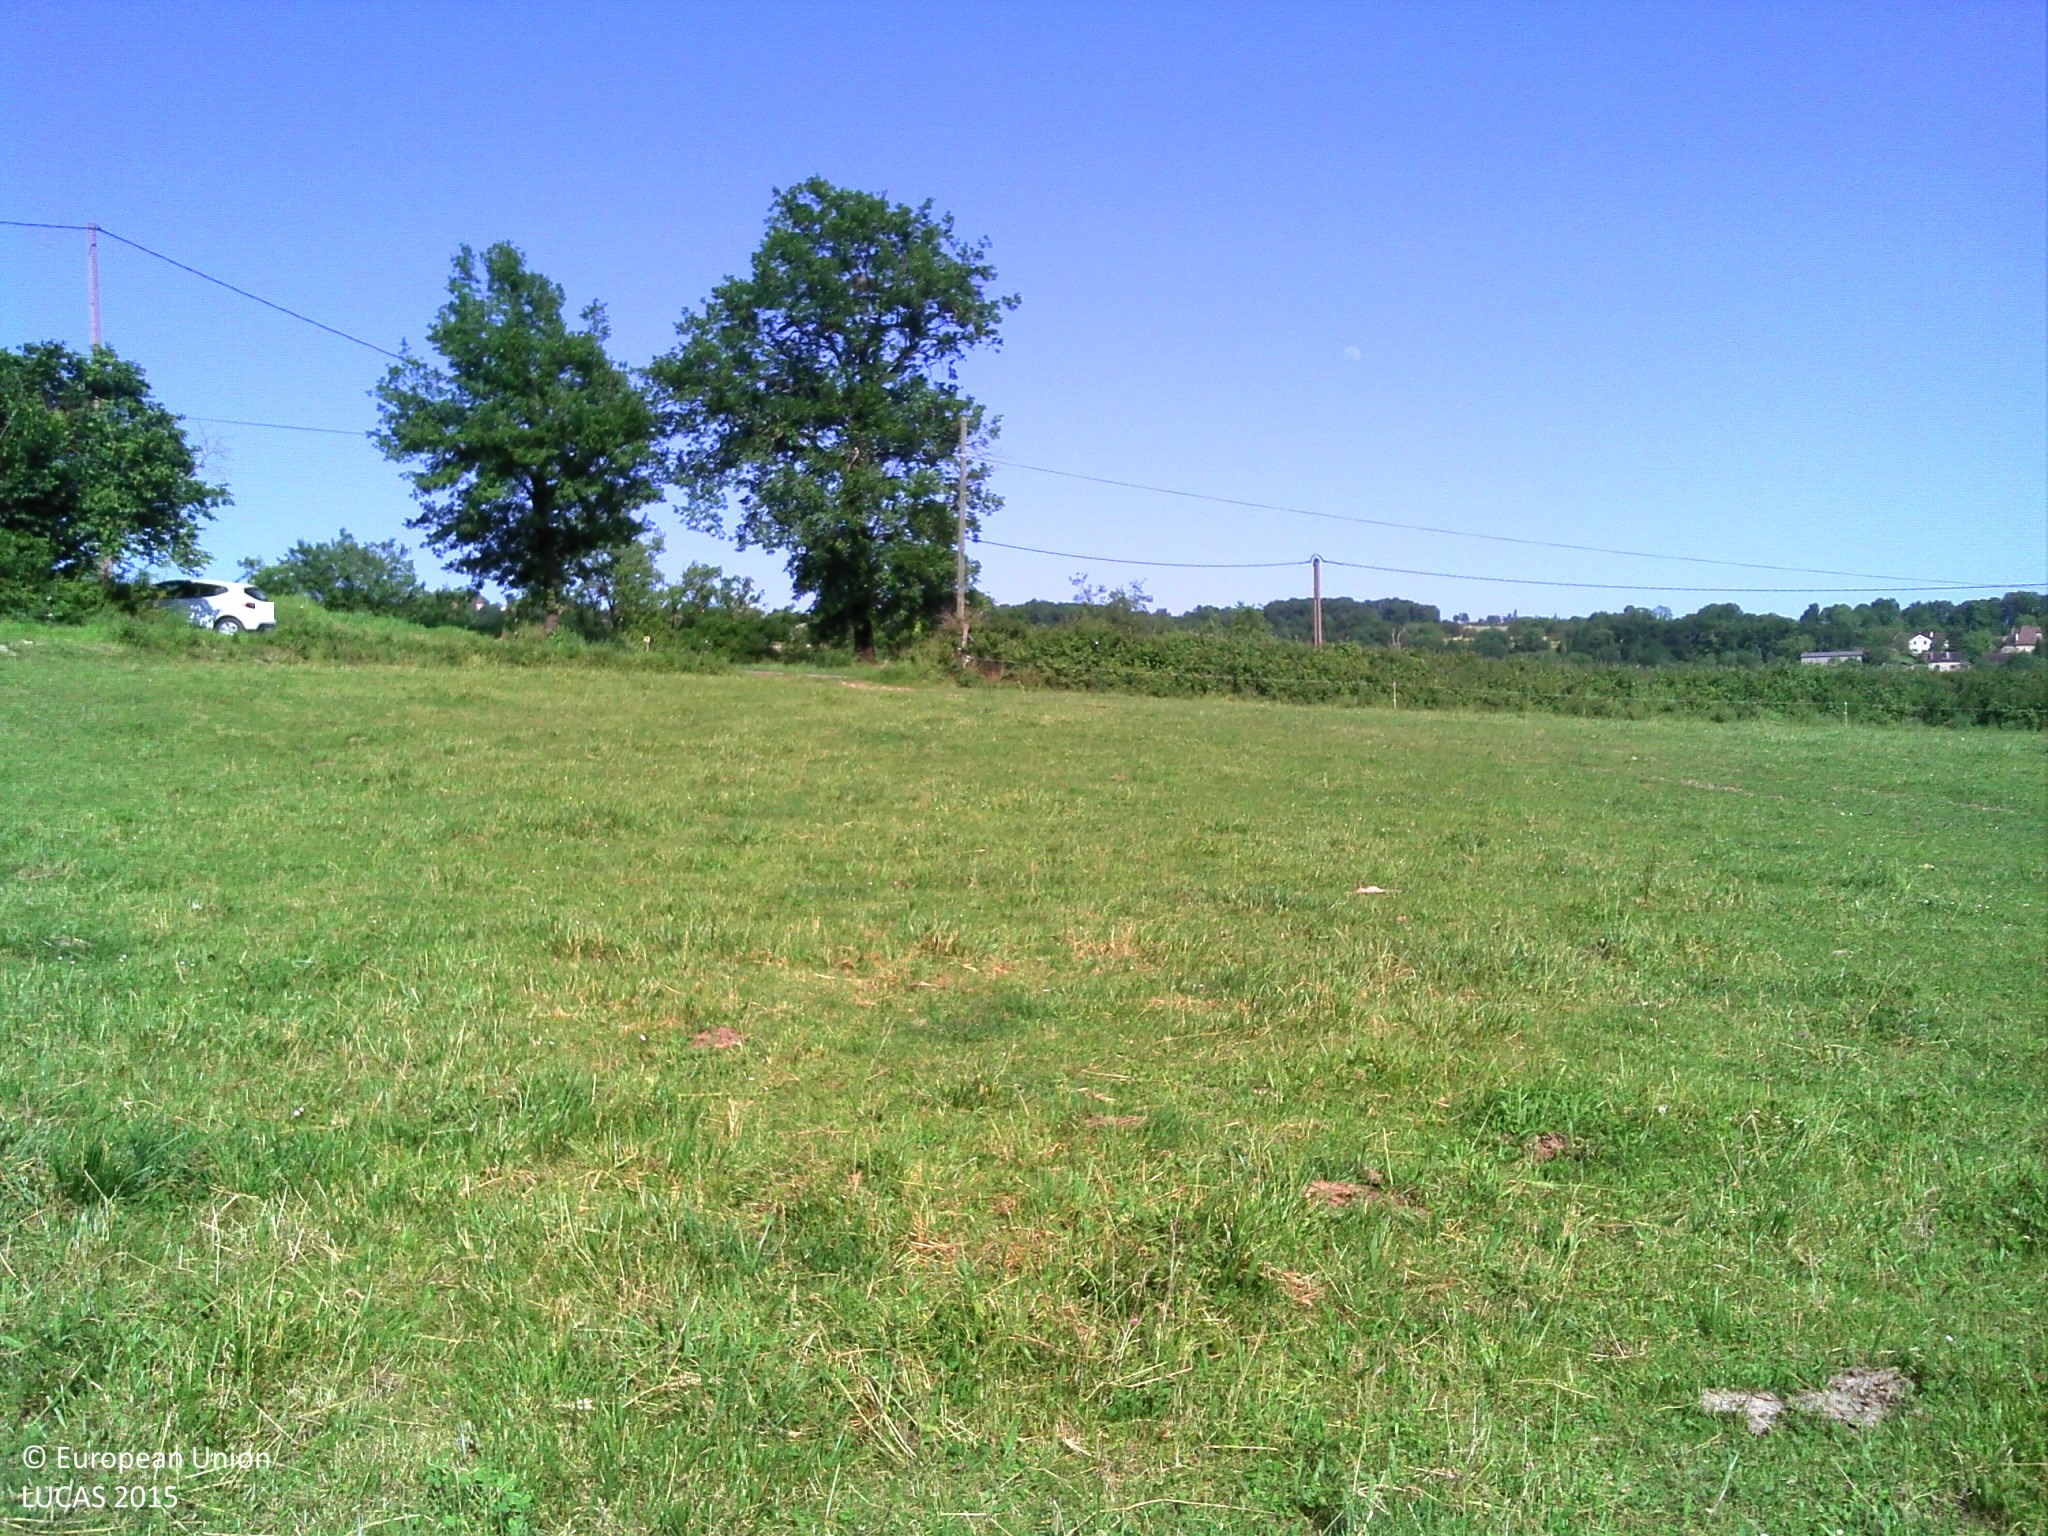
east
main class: Grassland
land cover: Grassland without tree/shrub cover
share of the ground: > 75 %
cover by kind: herbaceous plants 100 %
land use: Agriculture (excluding fallow land and kitchen gardens)
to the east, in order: Grassland without tree/shrub cover; Fences; Electric lines; Paved roads, cycling and walking lanes; Tracks; Electric lines; Single bushes/trees; Tracks; Grass margins; Broadleaved woodland; Grassland without tree/shrub cover; Dry stone walls; Grassland without tree/shrub cover; Dry stone walls; Grassland without tree/shrub cover; Nuts trees; Electric lines; Grassland without tree/shrub cover
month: May
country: FR
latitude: 44.6566
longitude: 1.9920
